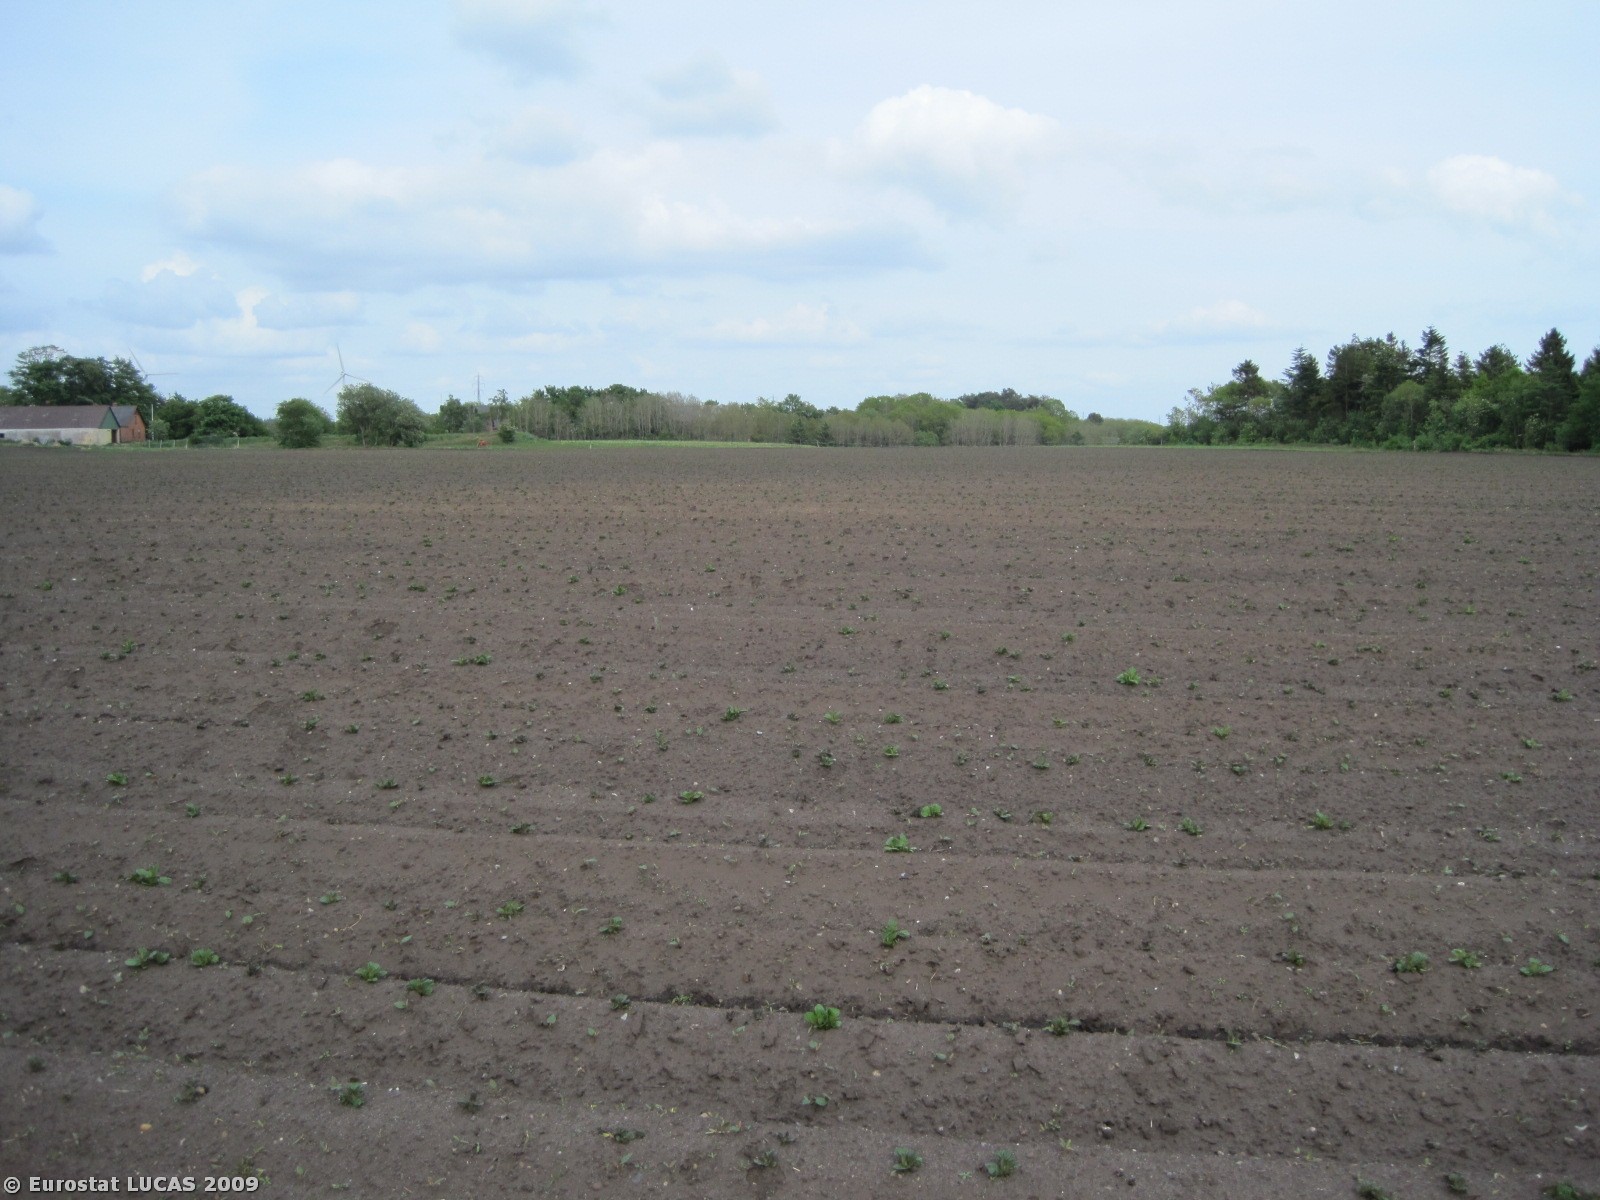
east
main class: Cropland
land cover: Potatoes
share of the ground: < 10 %
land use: Agriculture (excluding fallow land and kitchen gardens)
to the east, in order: Potatoes; Fences; Grassland without tree/shrub cover
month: May
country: DK
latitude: 56.3830
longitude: 9.2074
